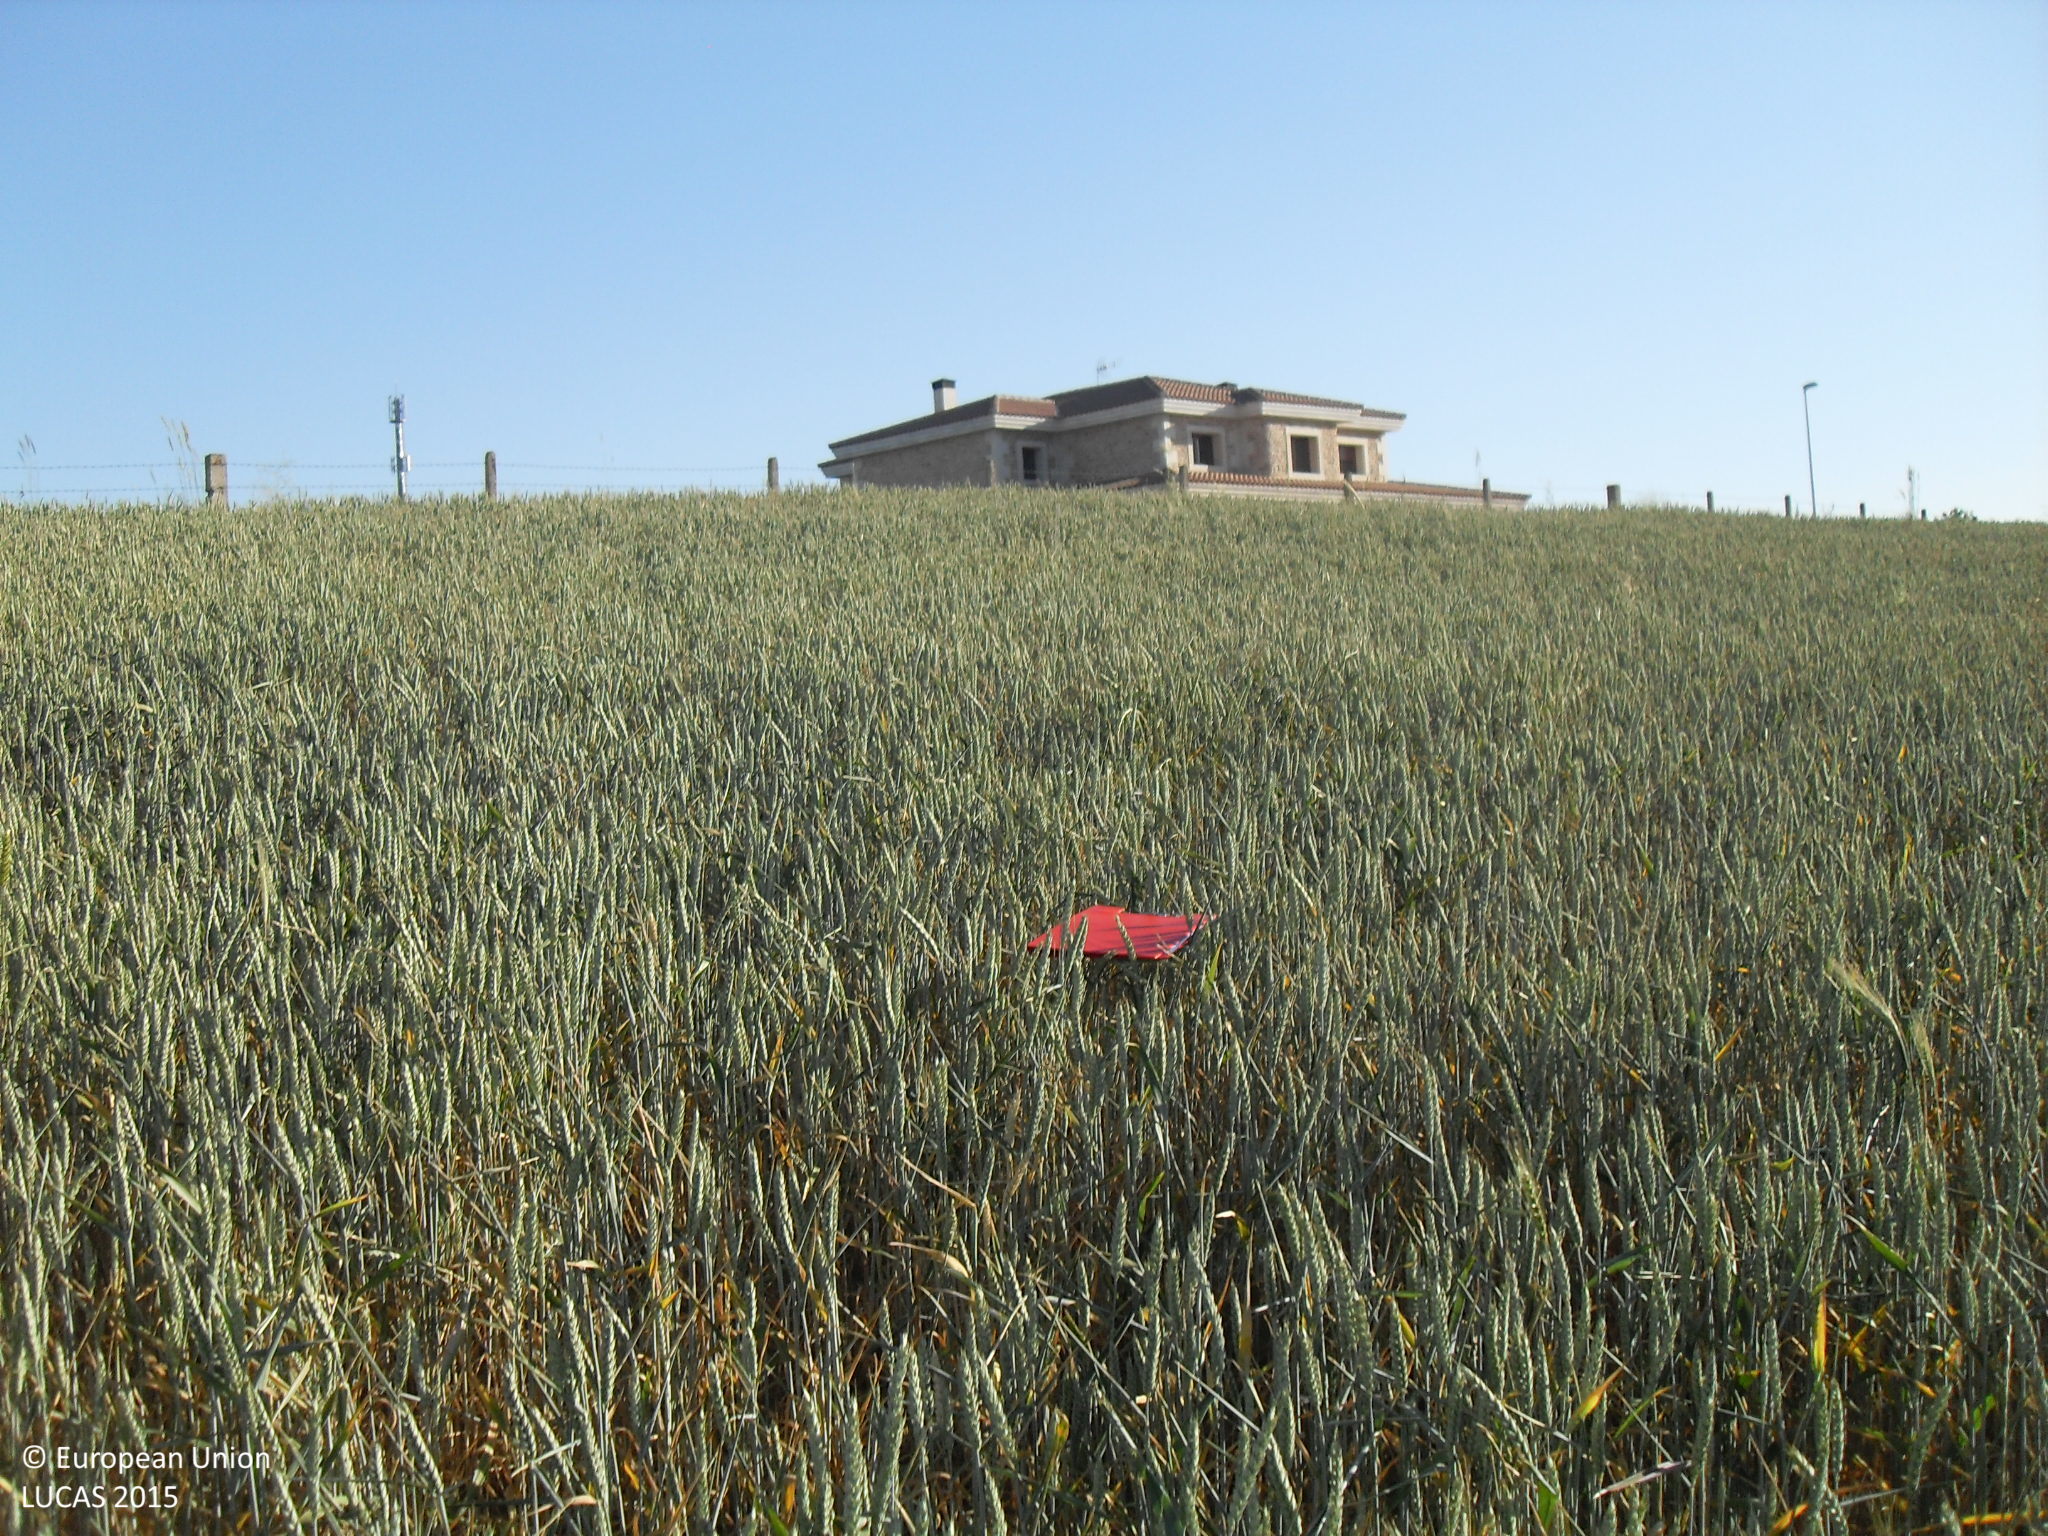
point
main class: Cropland
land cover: Common wheat
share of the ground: > 75 %
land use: Agriculture (excluding fallow land and kitchen gardens)
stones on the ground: < 10 %
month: June
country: ES
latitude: 40.5411
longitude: -5.5718
